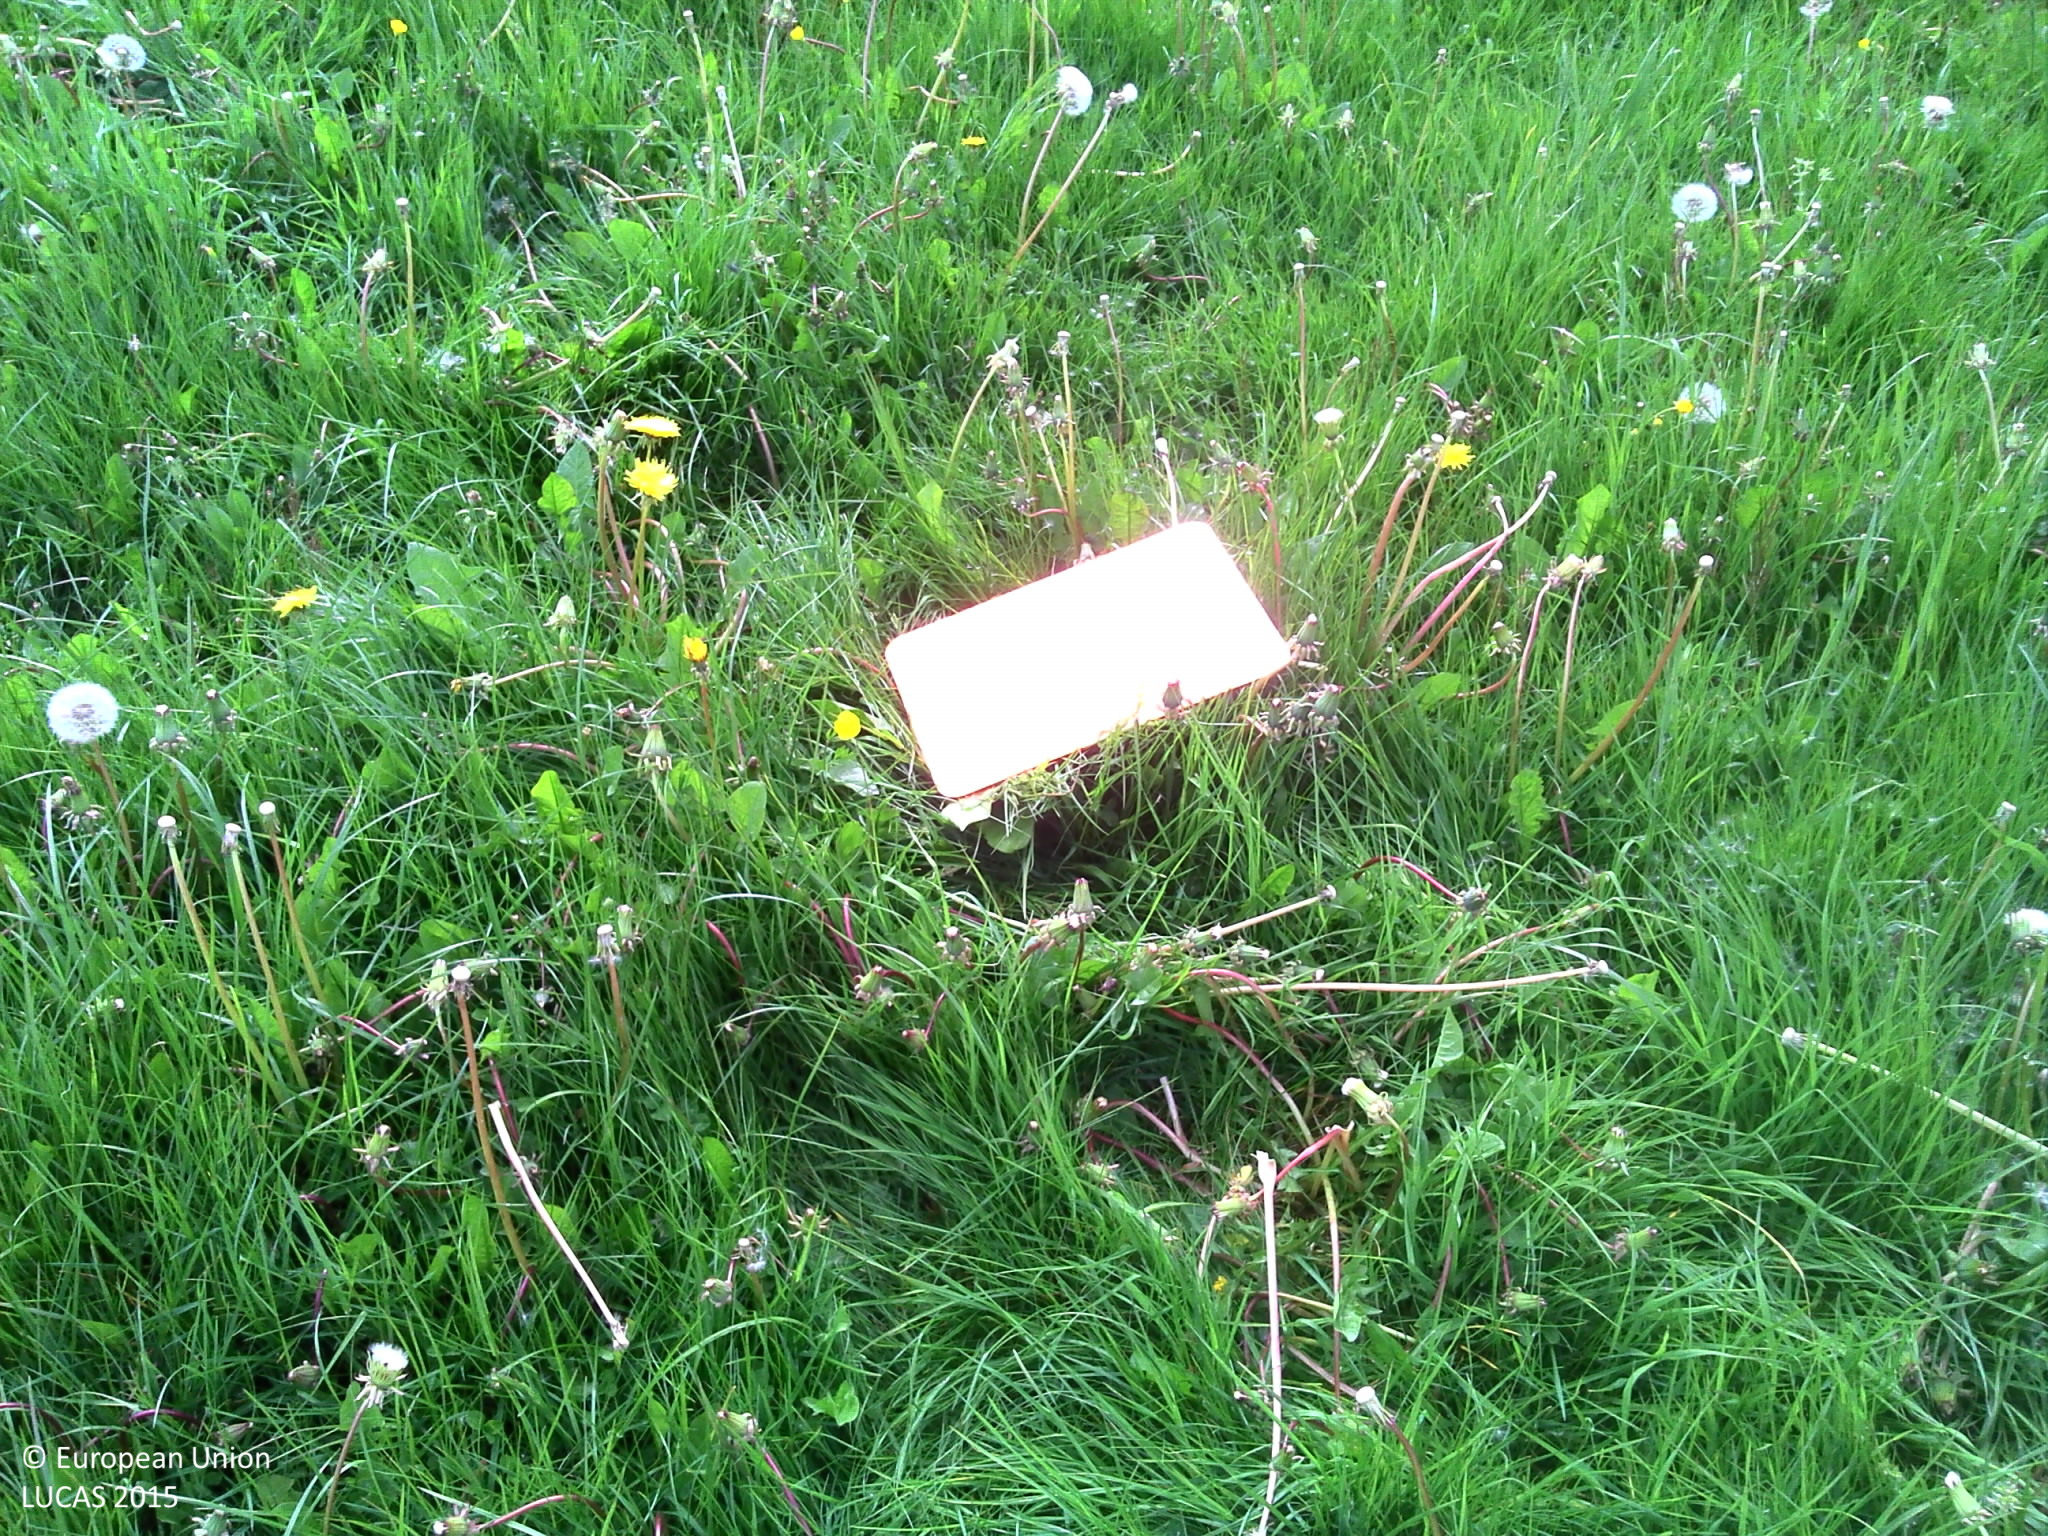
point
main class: Grassland
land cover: Grassland without tree/shrub cover
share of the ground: > 75 %
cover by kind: herbaceous plants 100 %
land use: Agriculture (excluding fallow land and kitchen gardens)
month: May
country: LU
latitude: 50.0588
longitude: 5.9622
